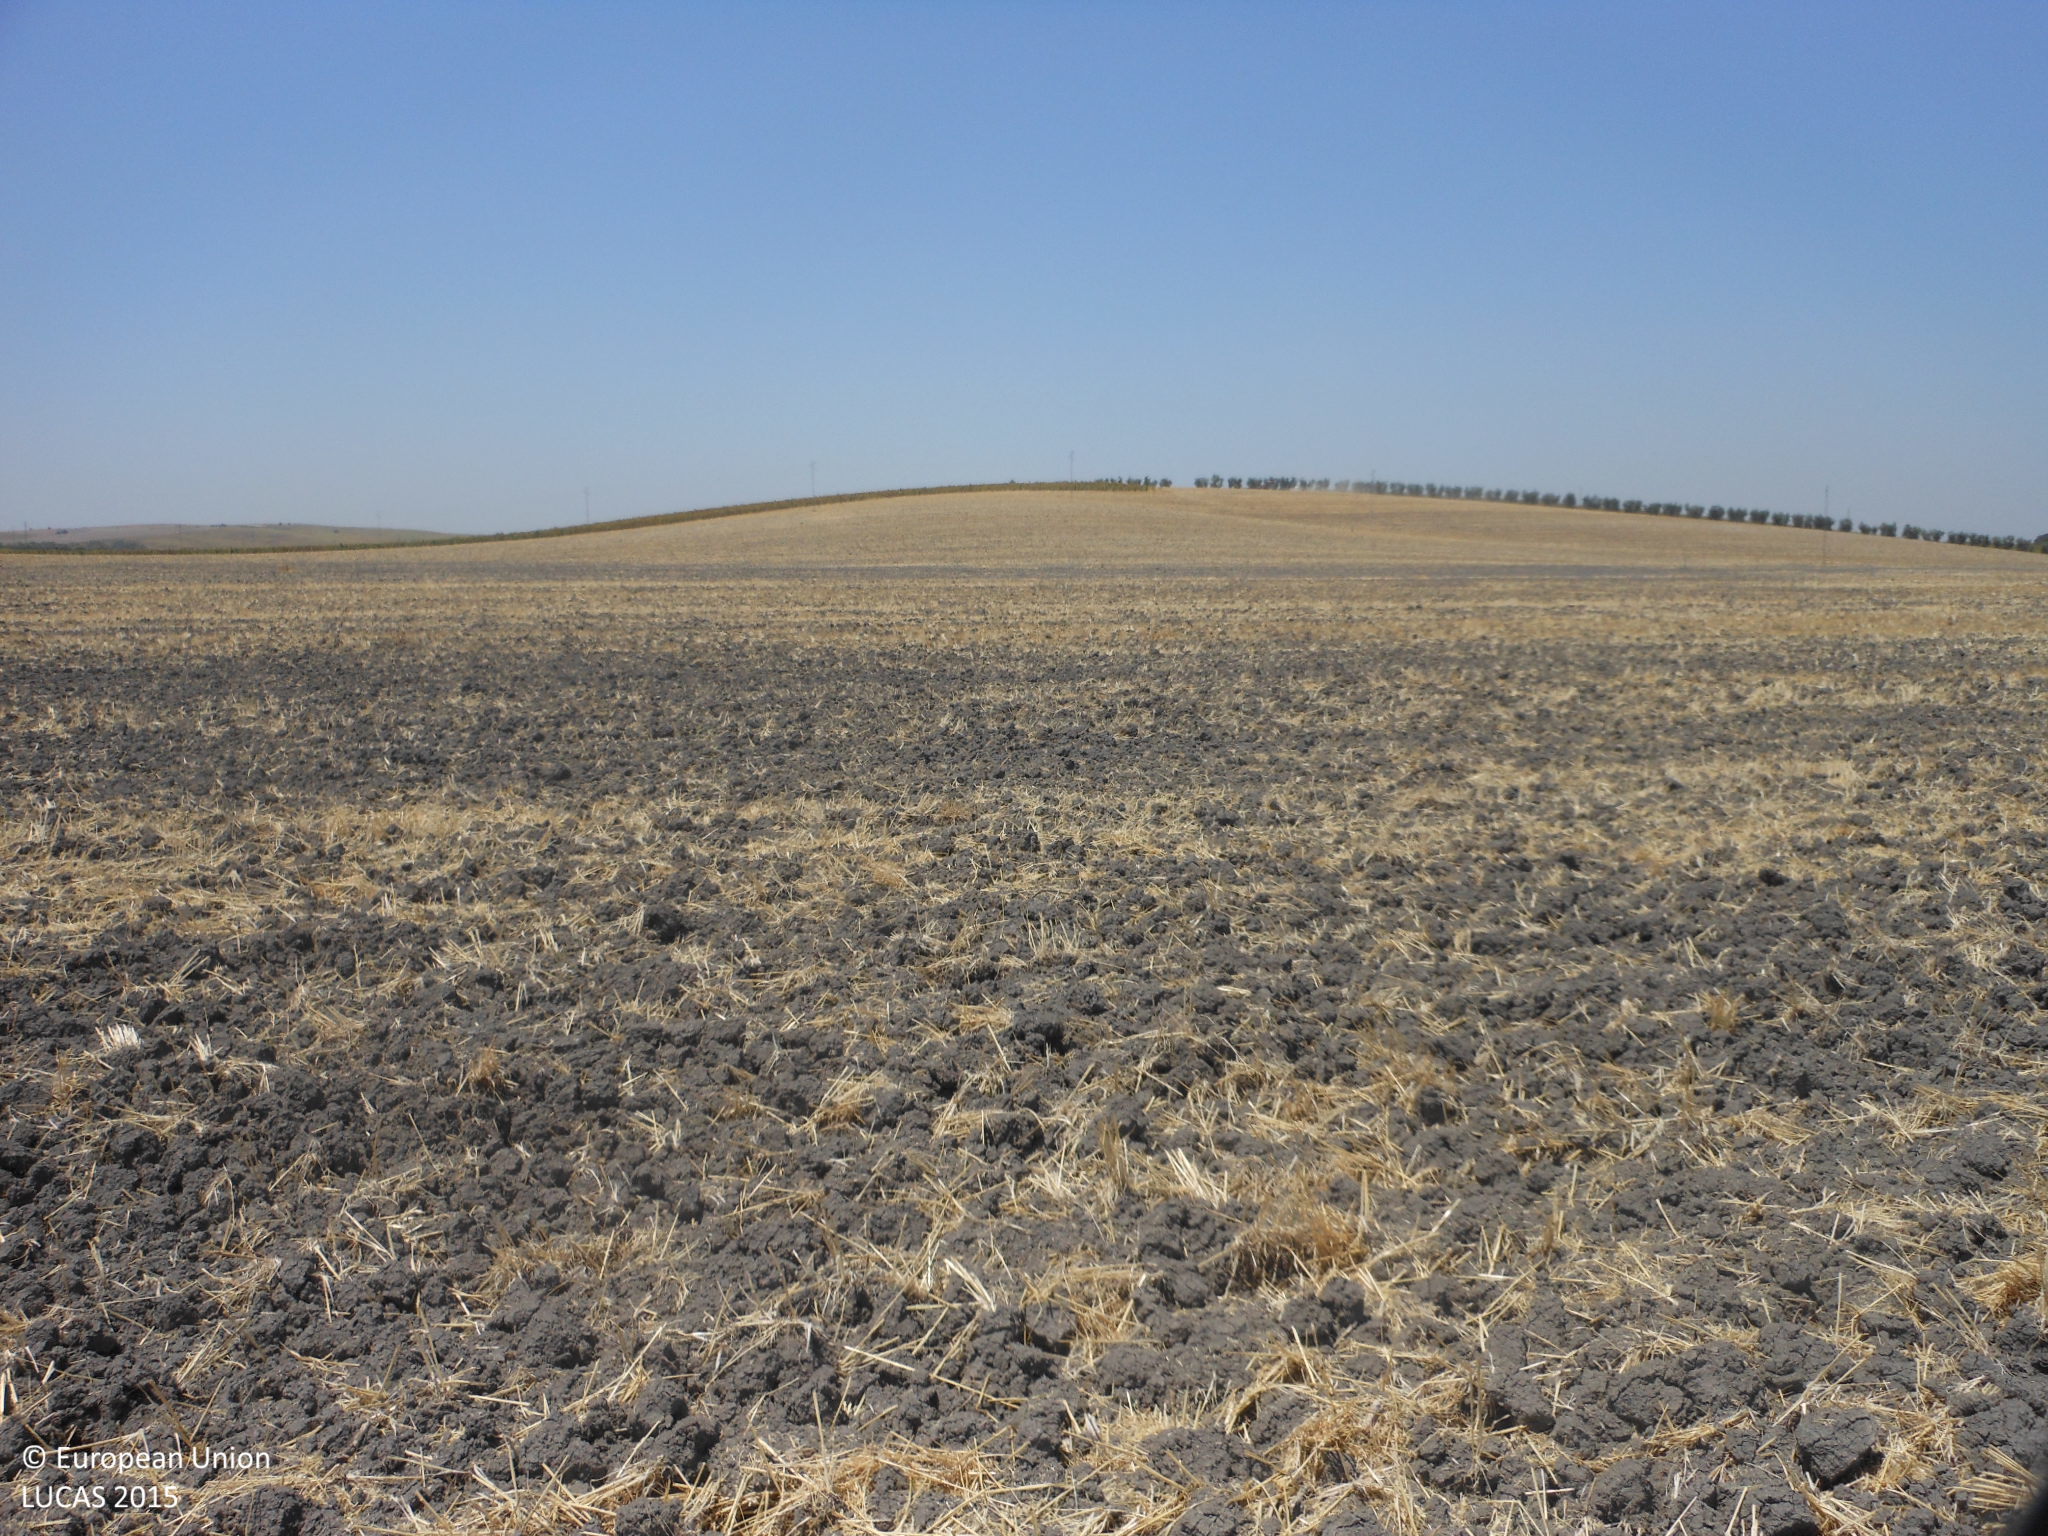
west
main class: Cropland
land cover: Common wheat
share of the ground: < 10 %
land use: Agriculture (excluding fallow land and kitchen gardens)
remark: Harvested field
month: June
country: ES
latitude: 37.1297
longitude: -5.5110
